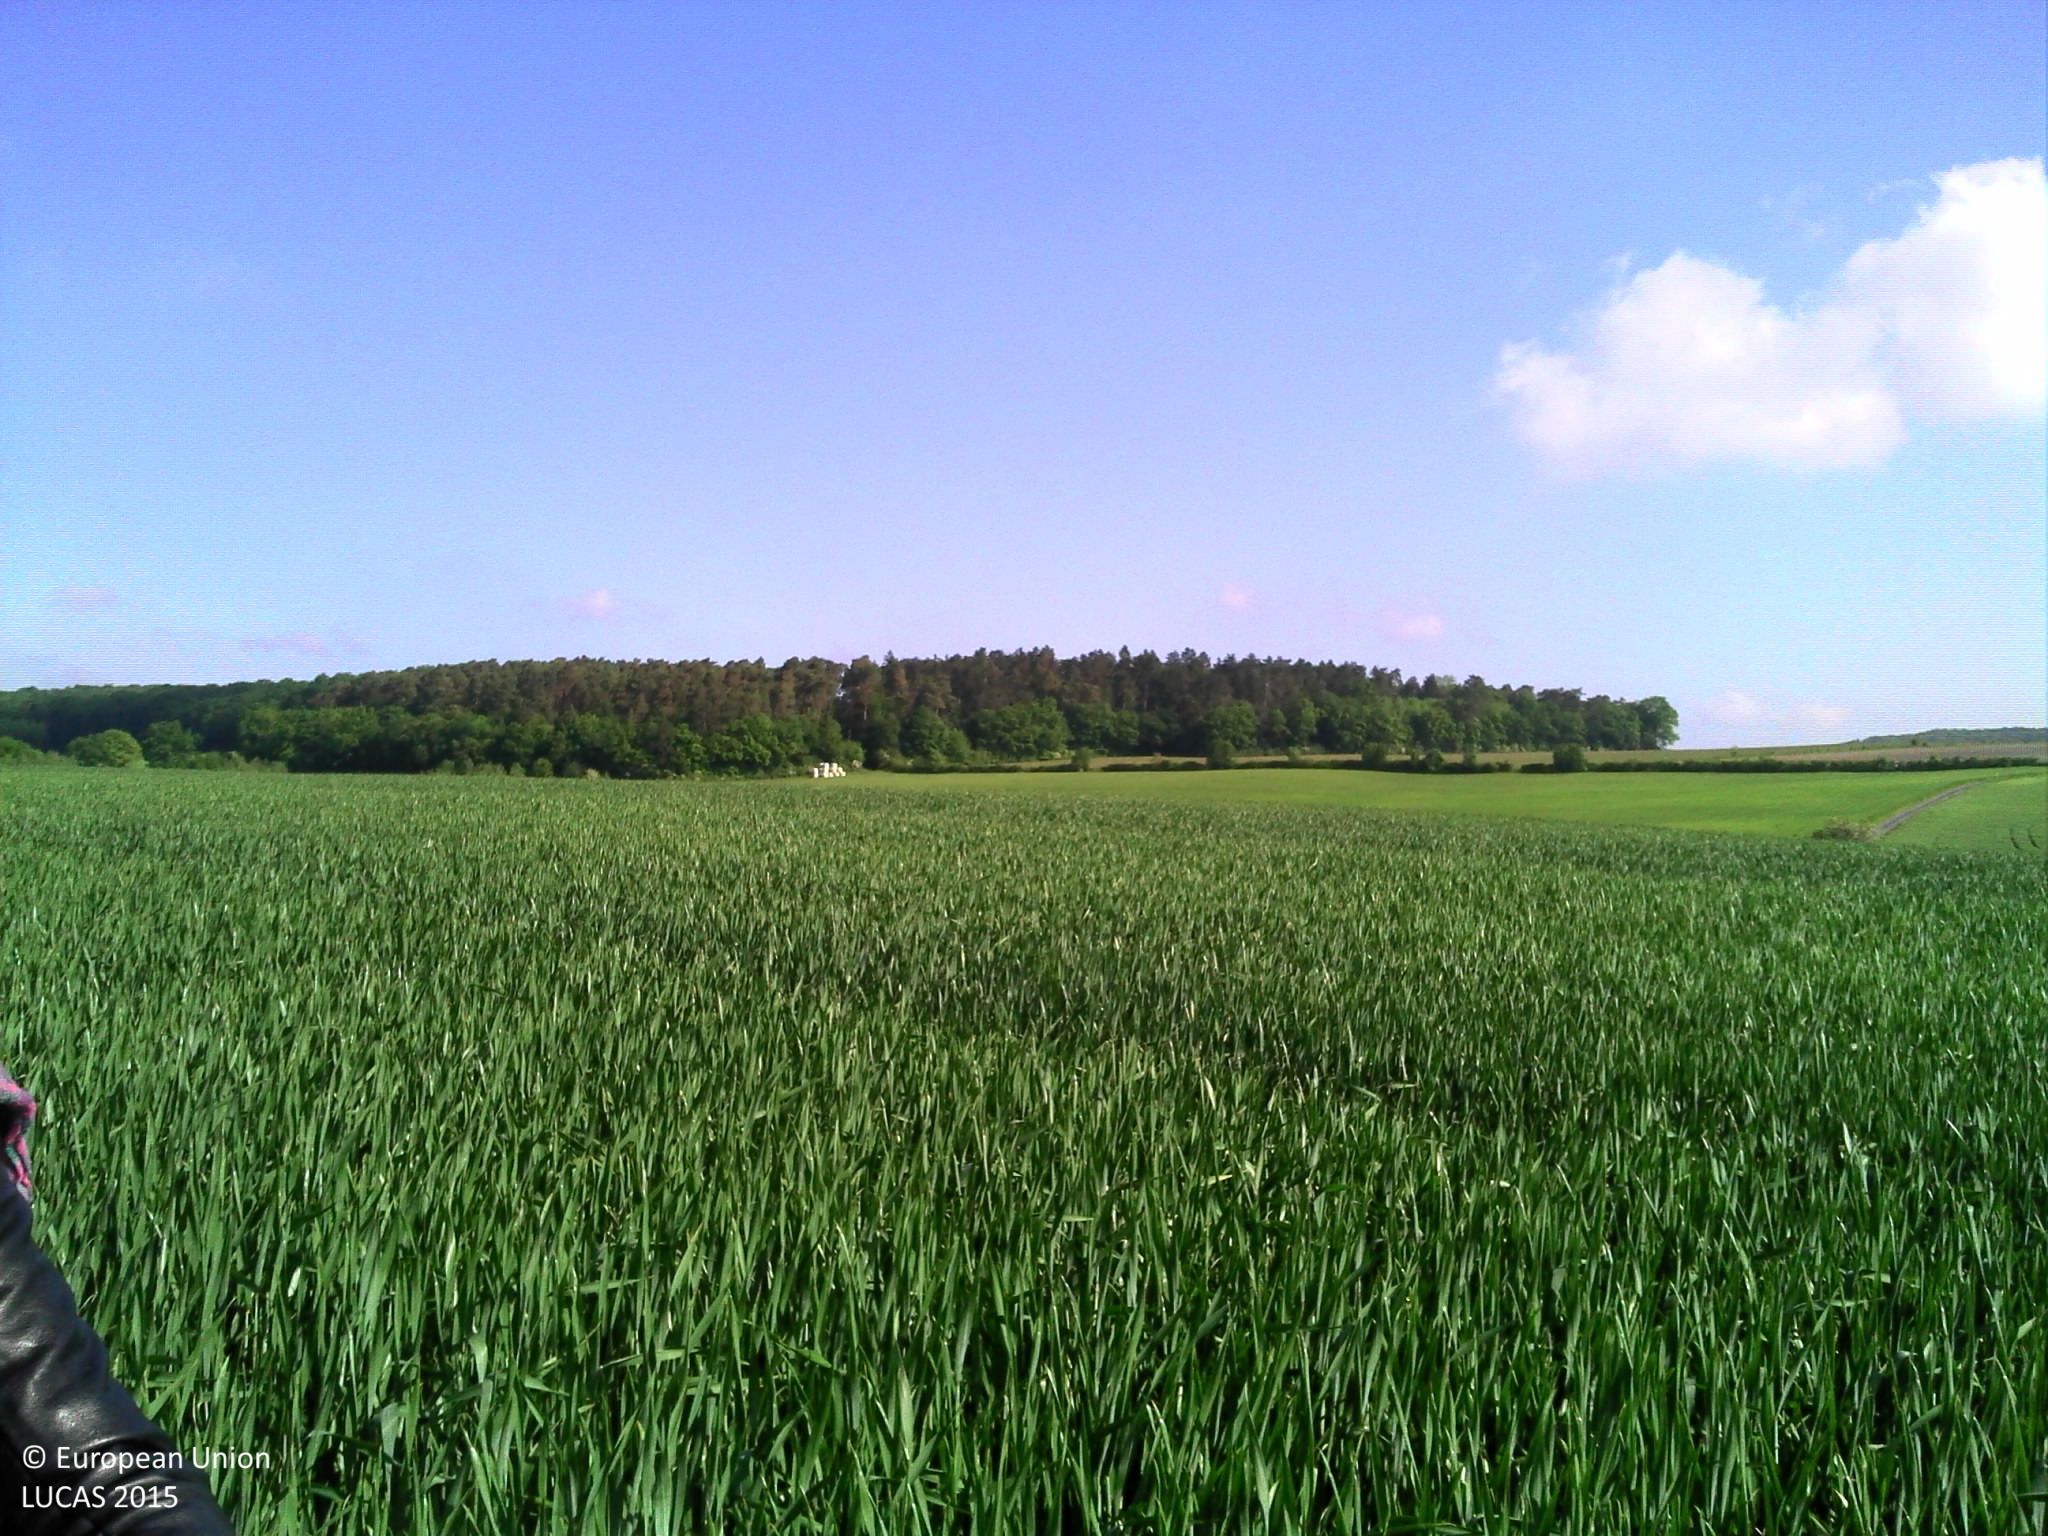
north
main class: Cropland
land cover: Common wheat
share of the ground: > 75 %
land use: Agriculture (excluding fallow land and kitchen gardens)
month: May
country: LU
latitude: 49.7137
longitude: 6.4077
